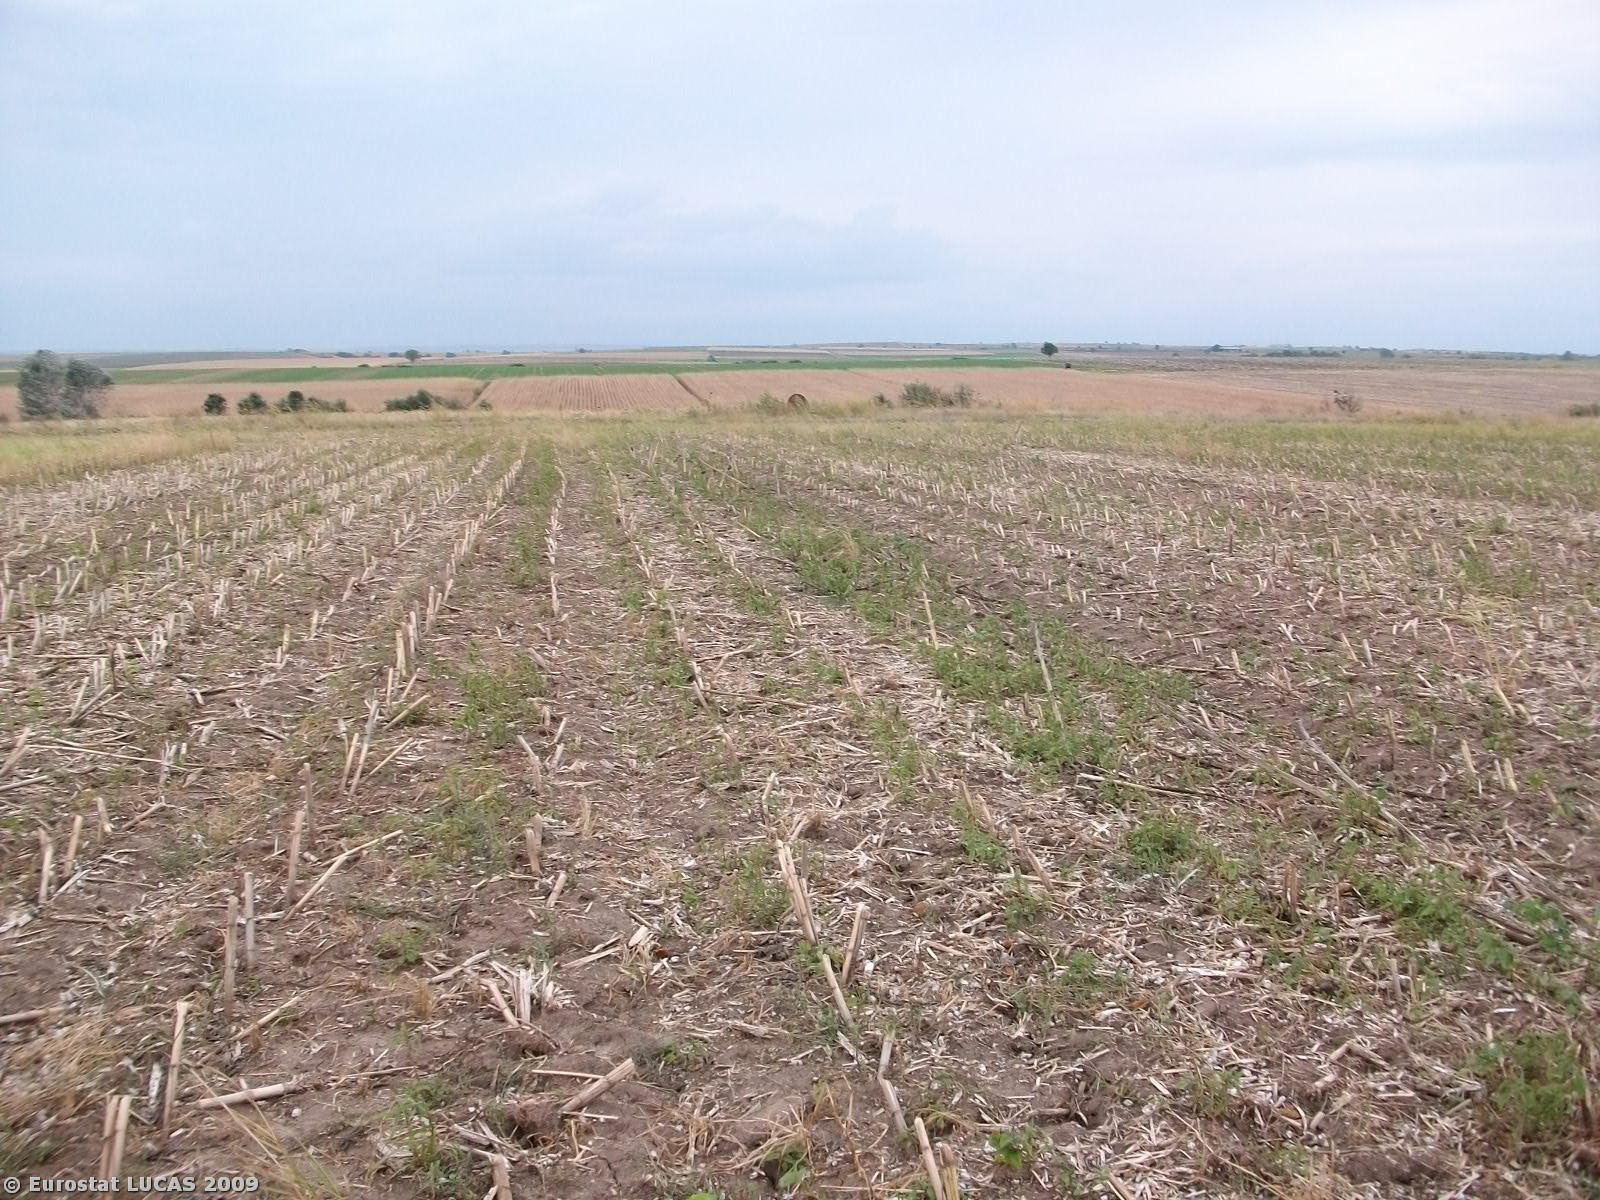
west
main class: Cropland
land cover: Sunflower
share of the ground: < 10 %
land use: Agriculture (excluding fallow land and kitchen gardens)
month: September
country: GR
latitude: 41.5449
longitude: 26.5149
